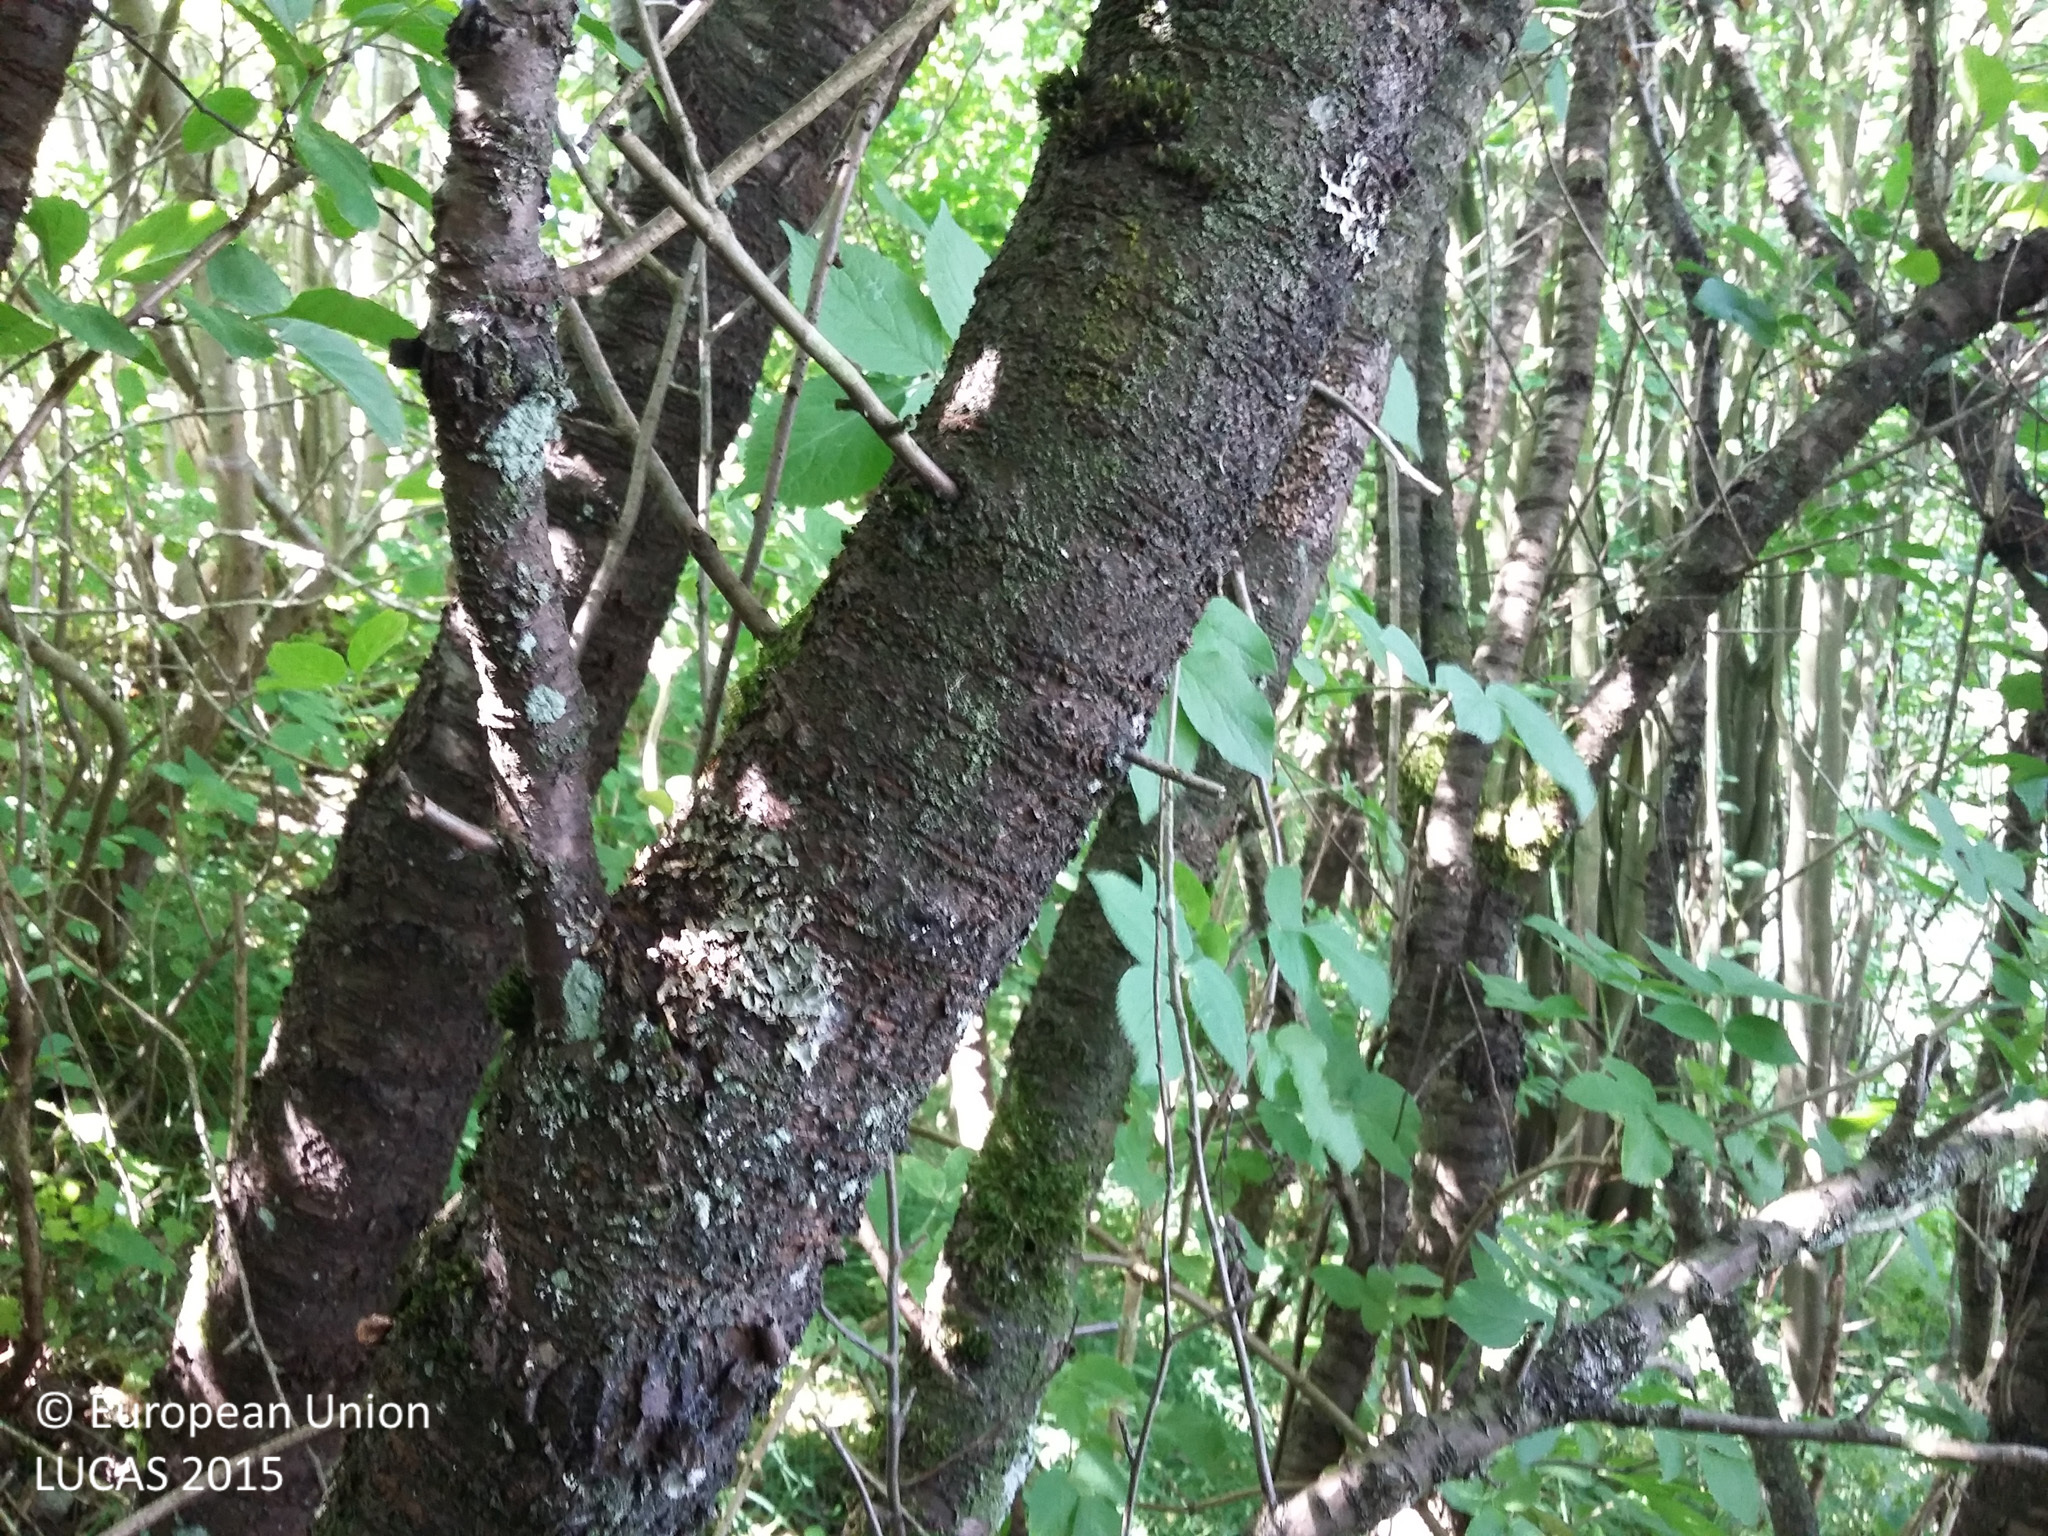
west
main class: Woodland
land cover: Broadleaved woodland
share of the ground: > 75 %
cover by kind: broadleaved forest trees 90 %, herbaceous plants 10 %
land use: Railway transport
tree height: > 5 m
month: July
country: DK
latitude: 55.5314
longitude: 11.5354
